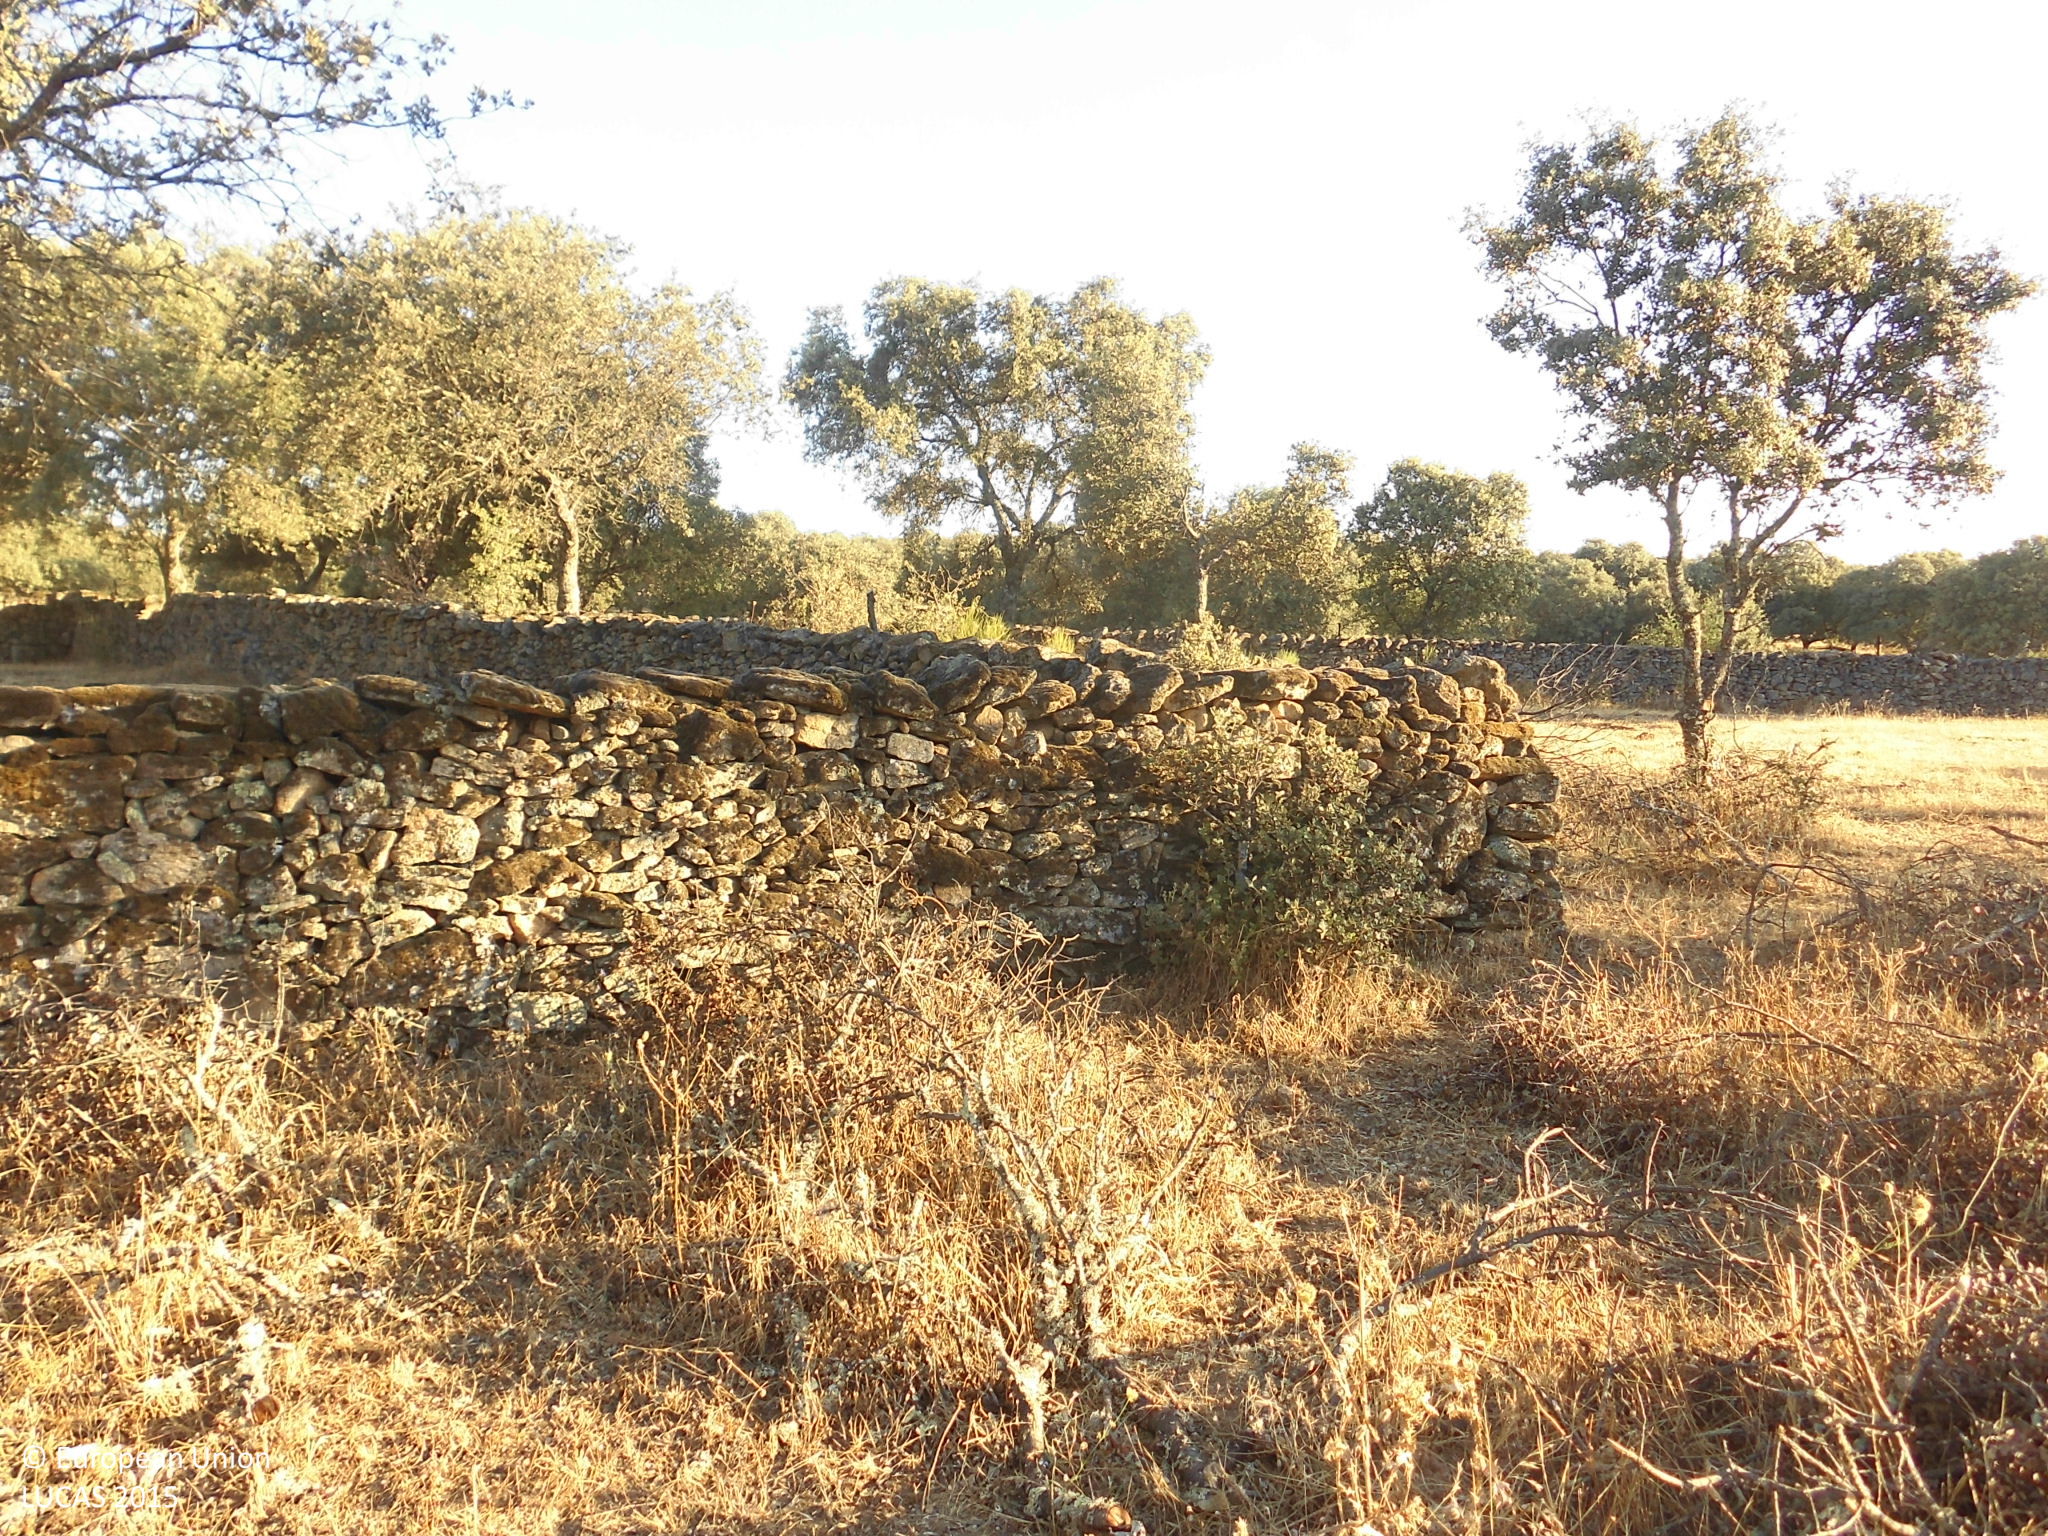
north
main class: Woodland
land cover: Broadleaved woodland
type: broadleaved evergreen forest
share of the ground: 25 - 50 %
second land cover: Grassland without tree/shrub cover
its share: > 75 %
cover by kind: herbaceous plants 65 %, broadleaved forest trees 35 %
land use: Forestry
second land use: Agriculture (excluding fallow land and kitchen gardens)
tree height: > 5 m
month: July
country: ES
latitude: 40.1102
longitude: -6.1829
